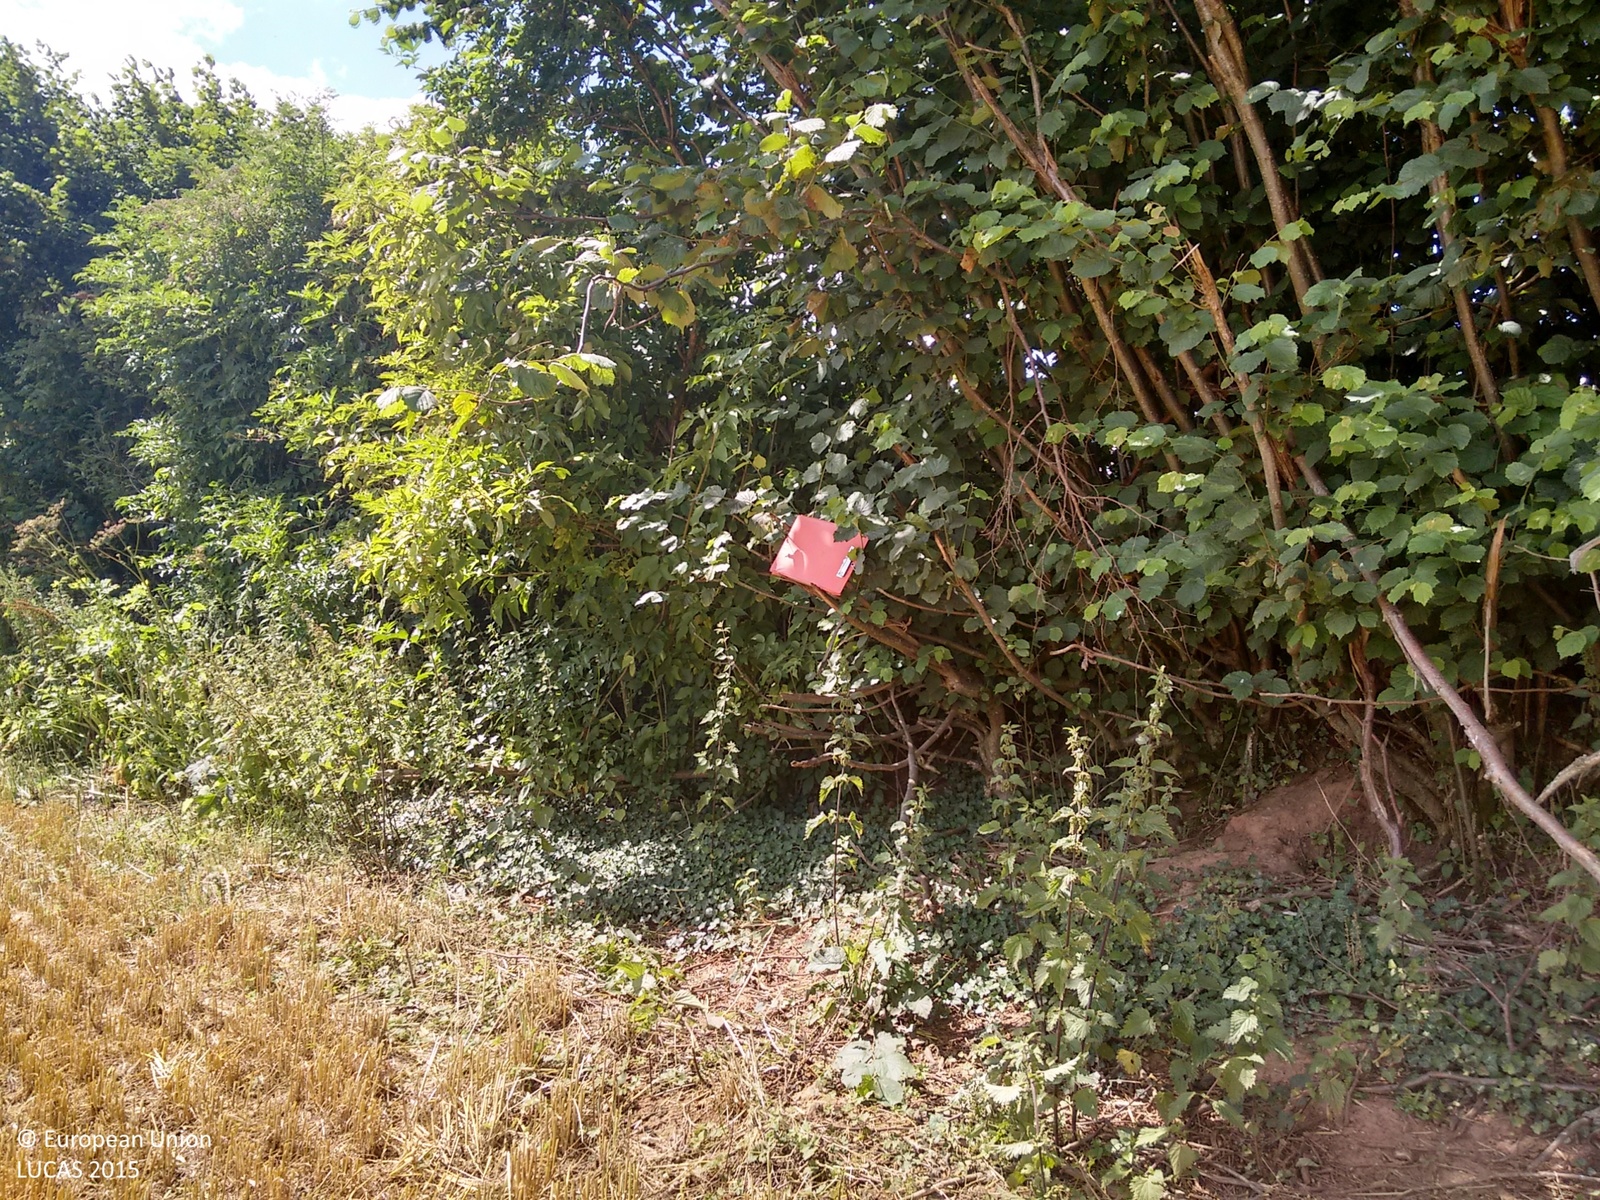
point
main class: Cropland
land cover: Barley
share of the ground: > 75 %
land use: Agriculture (excluding fallow land and kitchen gardens)
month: July
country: GB
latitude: 50.8001
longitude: -3.4921
